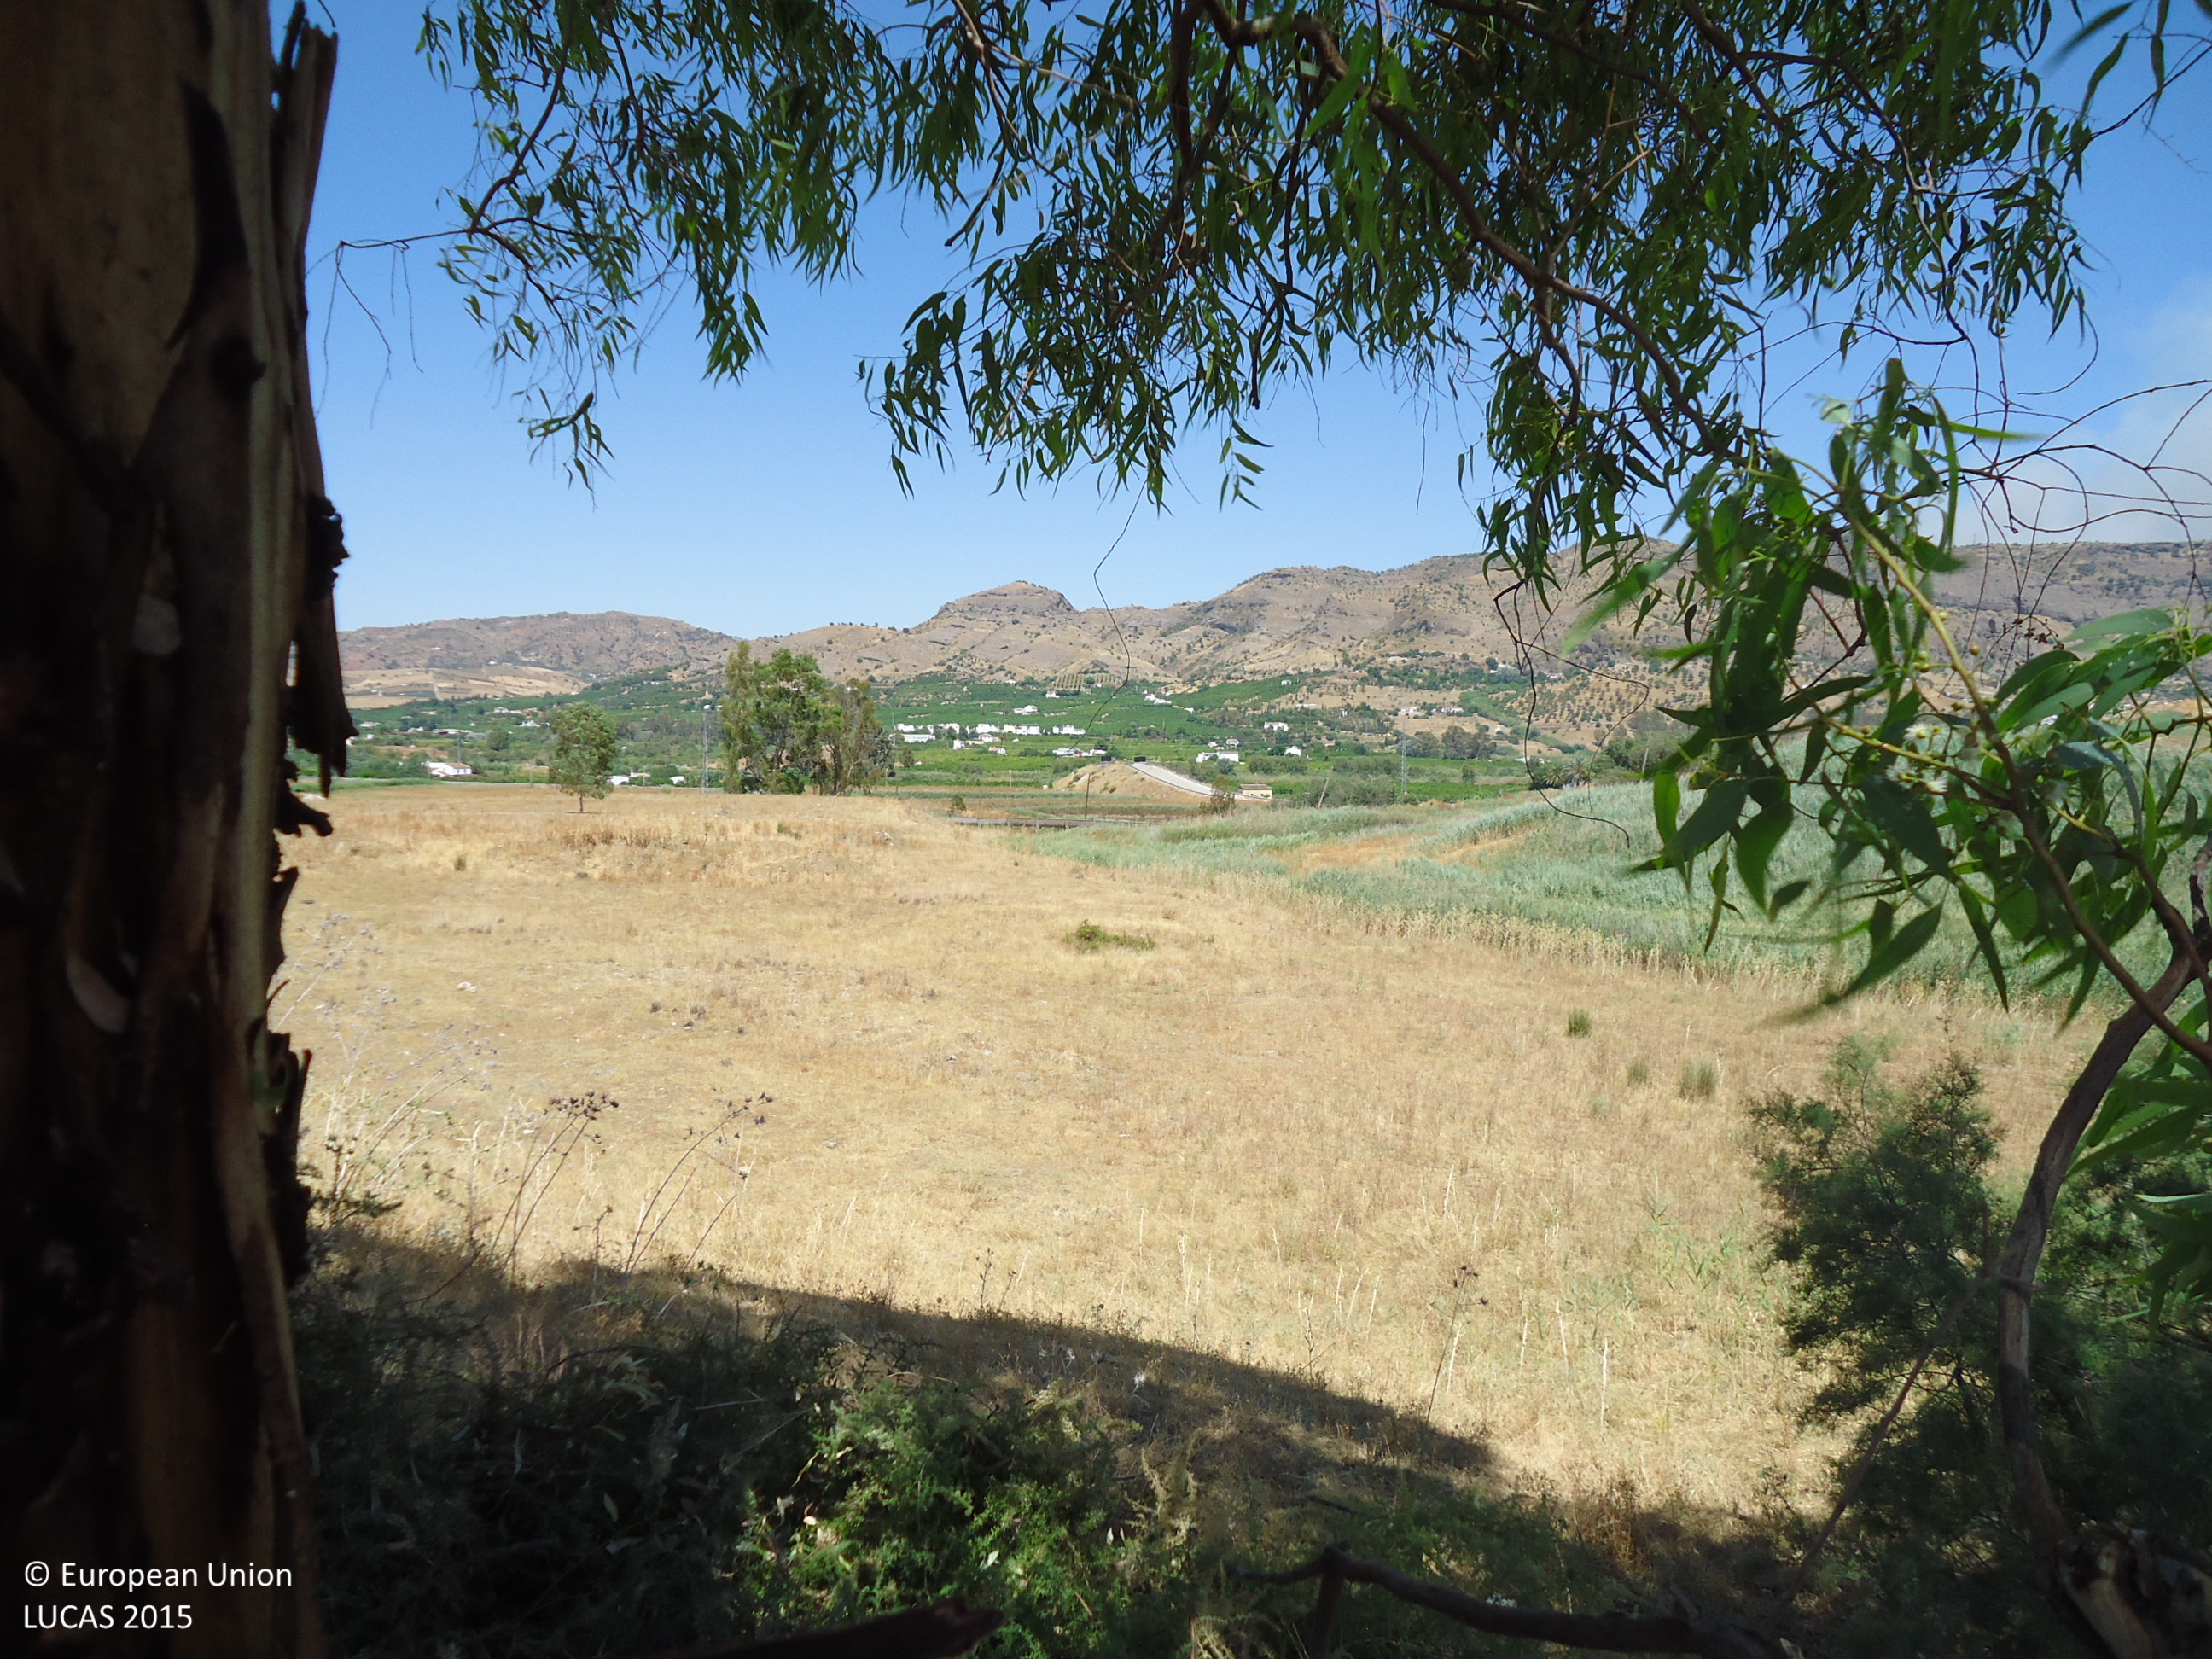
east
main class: Woodland
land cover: Broadleaved woodland
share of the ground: 25 - 50 %
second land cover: Grassland without tree/shrub cover
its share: > 75 %
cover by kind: herbaceous plants 70 %, broadleaved forest trees 30 %
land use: Forestry
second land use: Agriculture (excluding fallow land and kitchen gardens)
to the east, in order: Broadleaved woodland; Grassland without tree/shrub cover; Rivers and streams; Grassland without tree/shrub cover; Inland fresh water bodies; Grassland without tree/shrub cover; Fences; Tracks; Electric lines; Ditches and canals; Shrubland with sparse tree cover
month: June
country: ES
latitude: 36.7779
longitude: -4.7283
